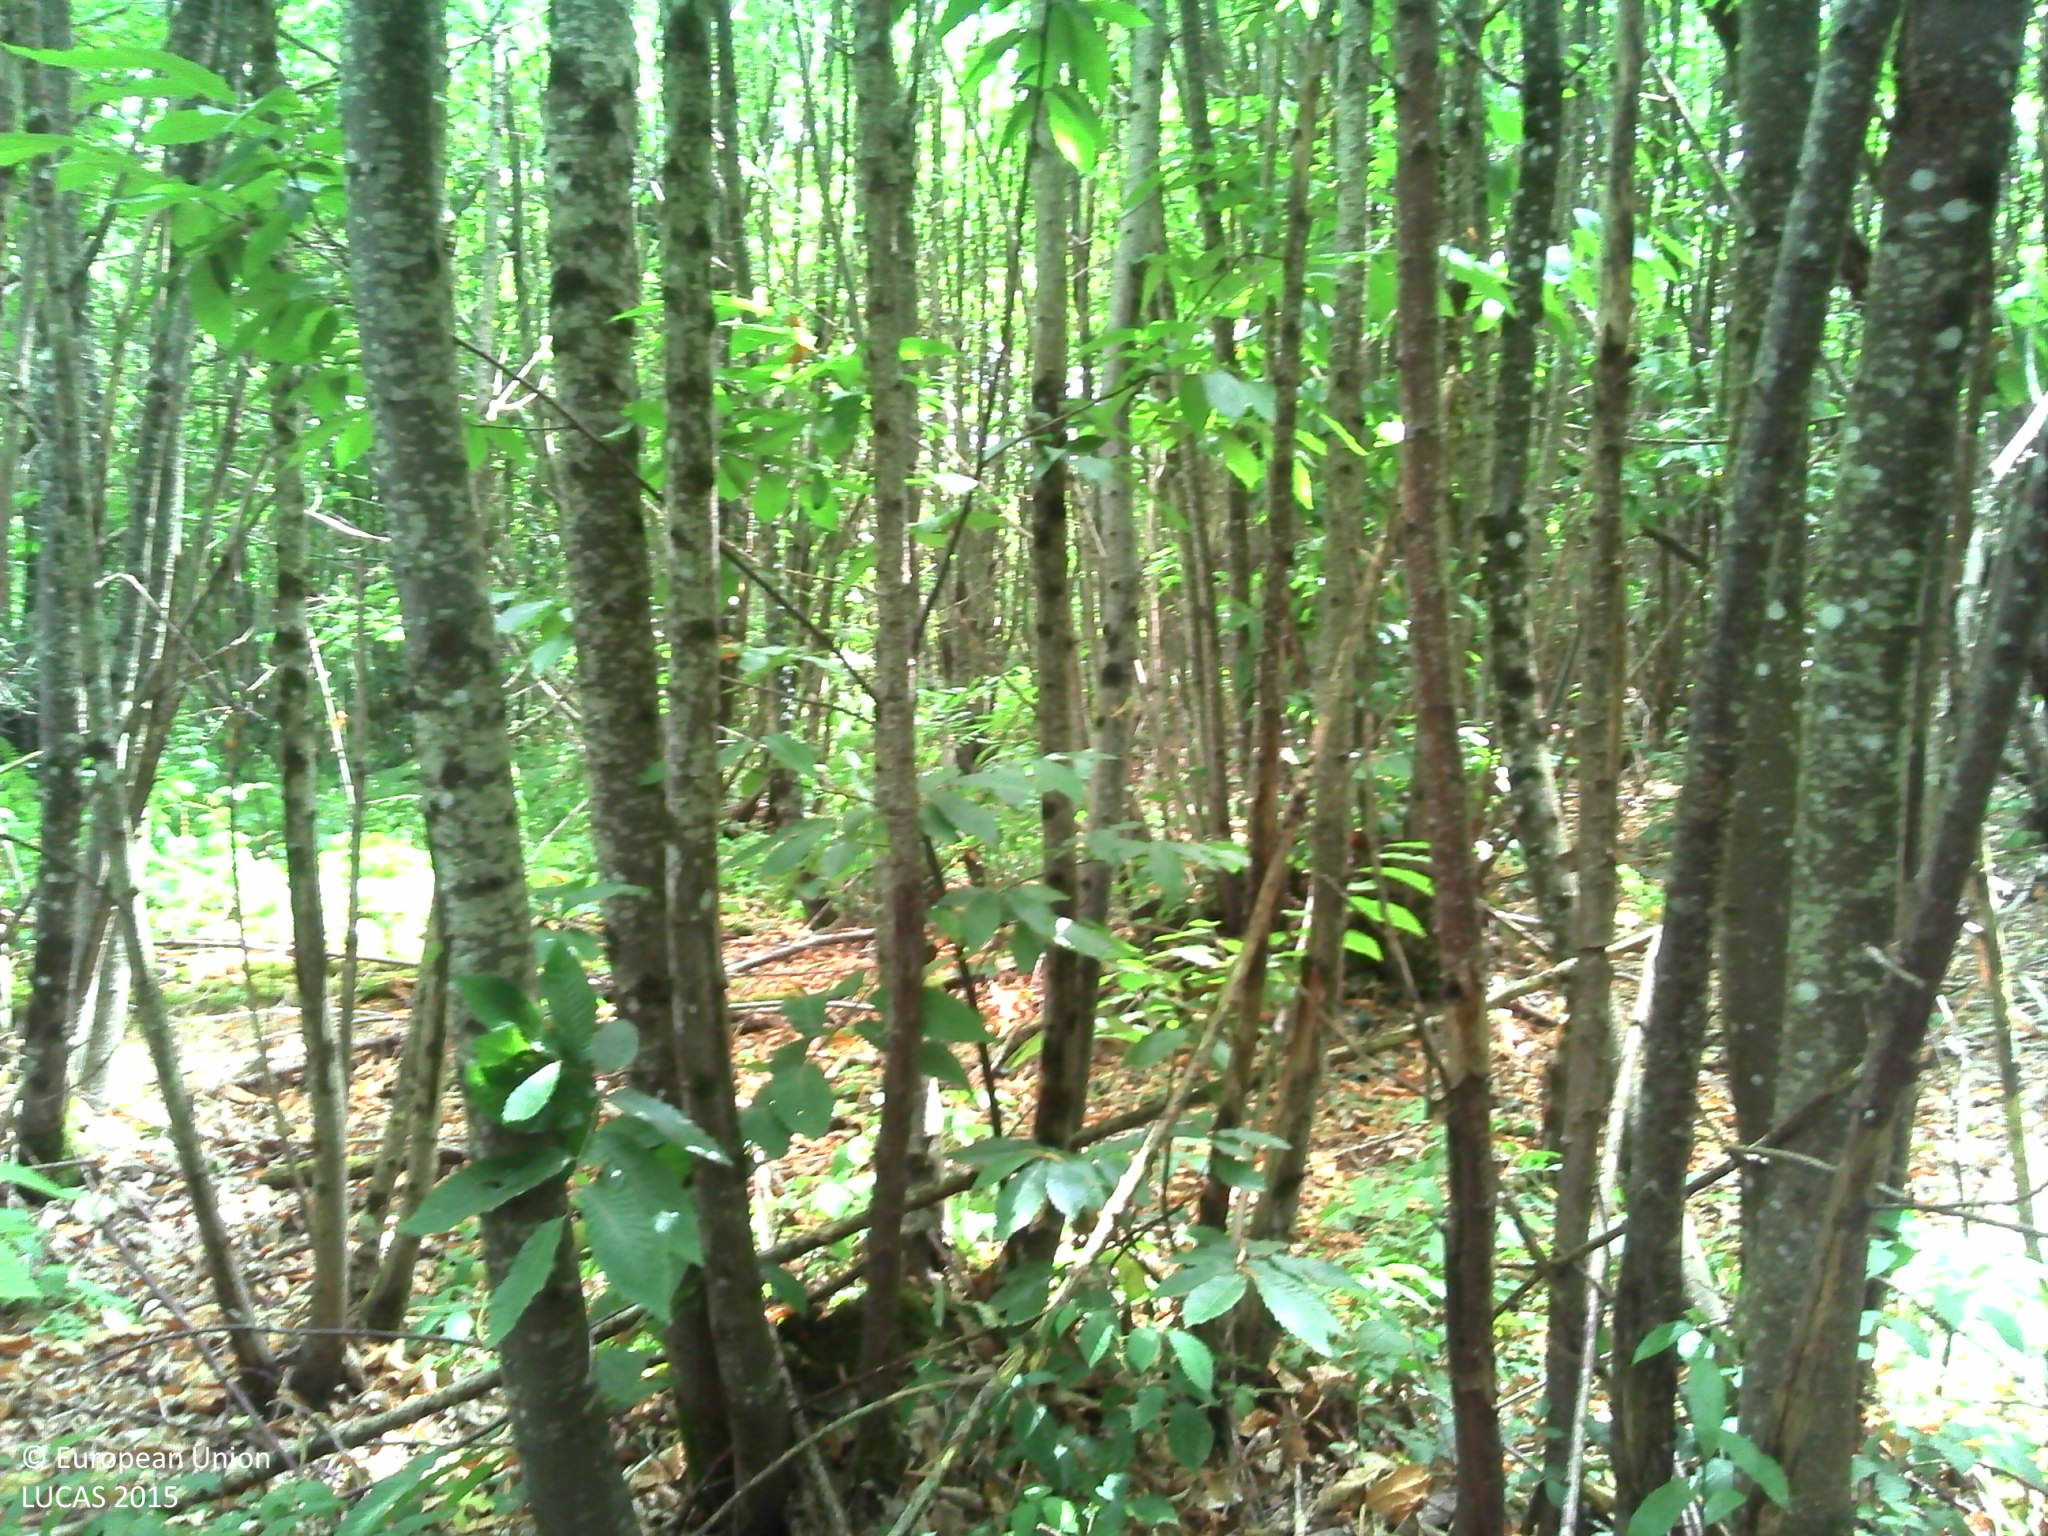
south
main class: Woodland
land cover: Broadleaved woodland
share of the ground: > 75 %
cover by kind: broadleaved forest trees 40 %, herbaceous plants 30 %, lichens and mosses 20 %, unconsolidated bare surface 10 %
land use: Forestry
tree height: > 5 m
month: July
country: FR
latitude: 45.6847
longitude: 1.0407
